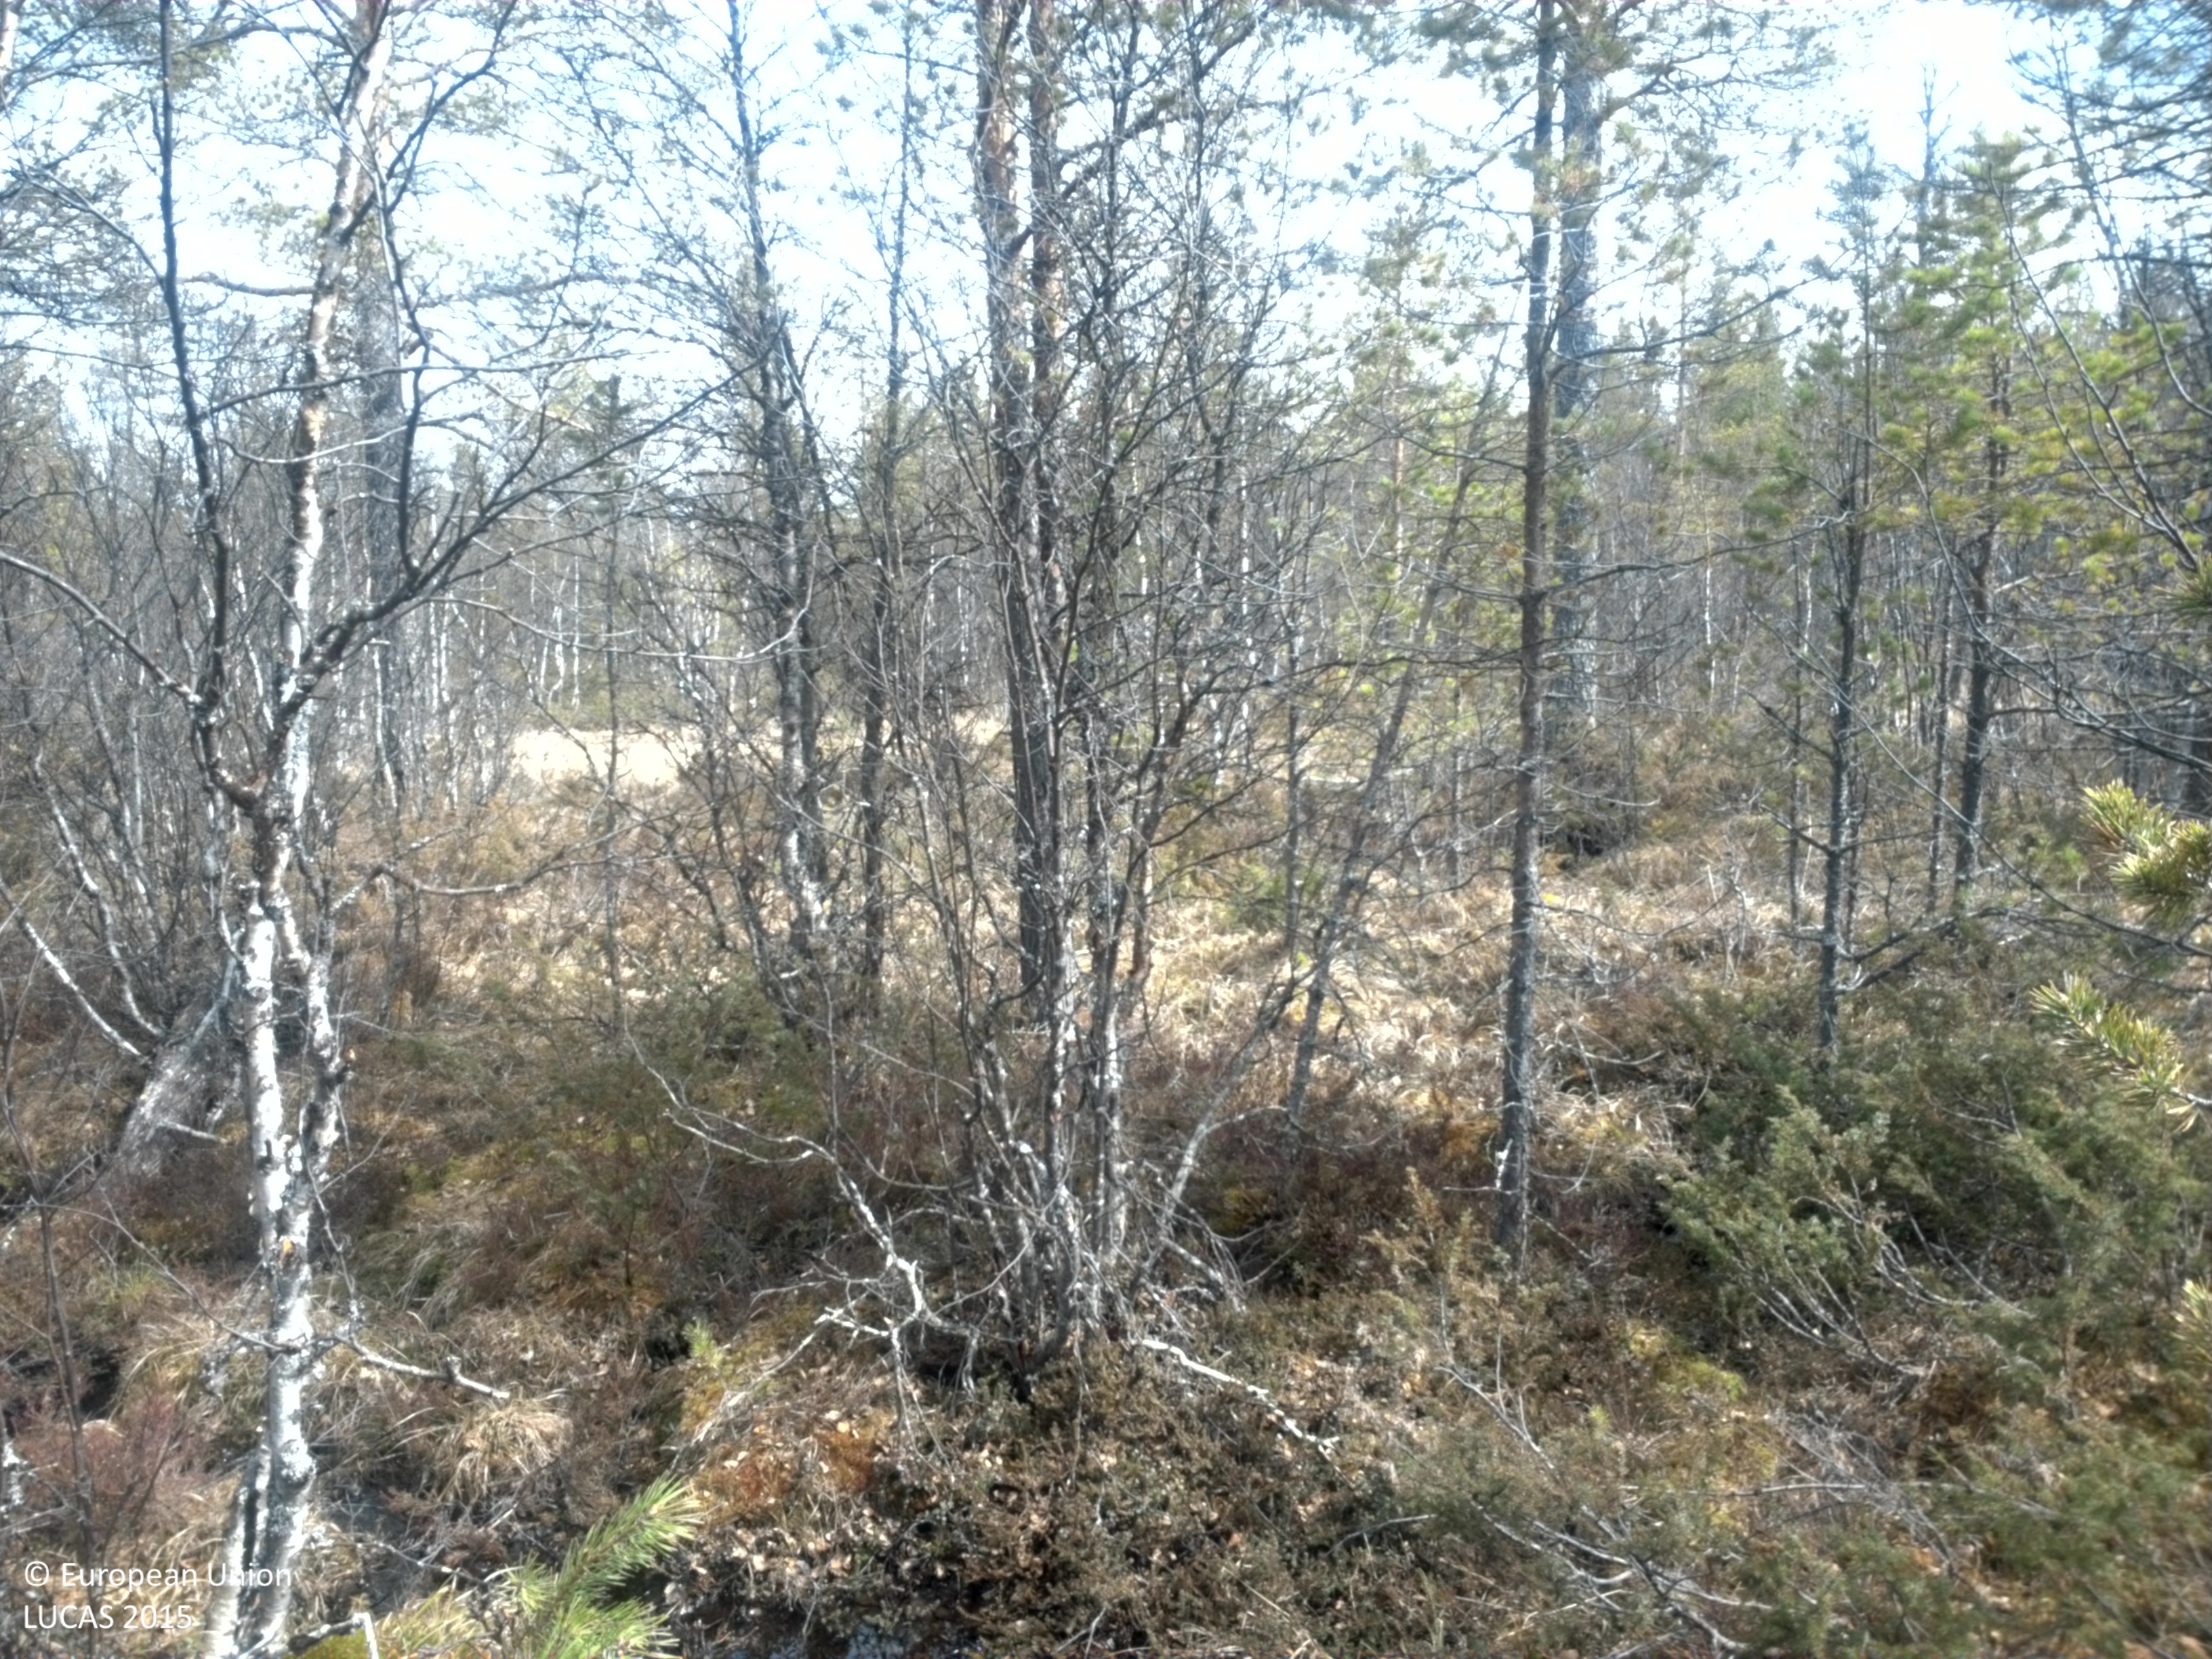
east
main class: Woodland
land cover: Pine dominated mixed woodland
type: boreal forest
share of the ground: 50 - 75 %
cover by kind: coniferous forest trees 50 %, shrubs 30 %, broadleaved forest trees 20 %
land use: Forestry
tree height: > 5 m
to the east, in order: Pine dominated mixed woodland; Rivers and streams; Pine dominated mixed woodland; Pine dominated coniferous woodland; Pine dominated mixed woodland
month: May
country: SE
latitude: 62.6909
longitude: 13.7928
